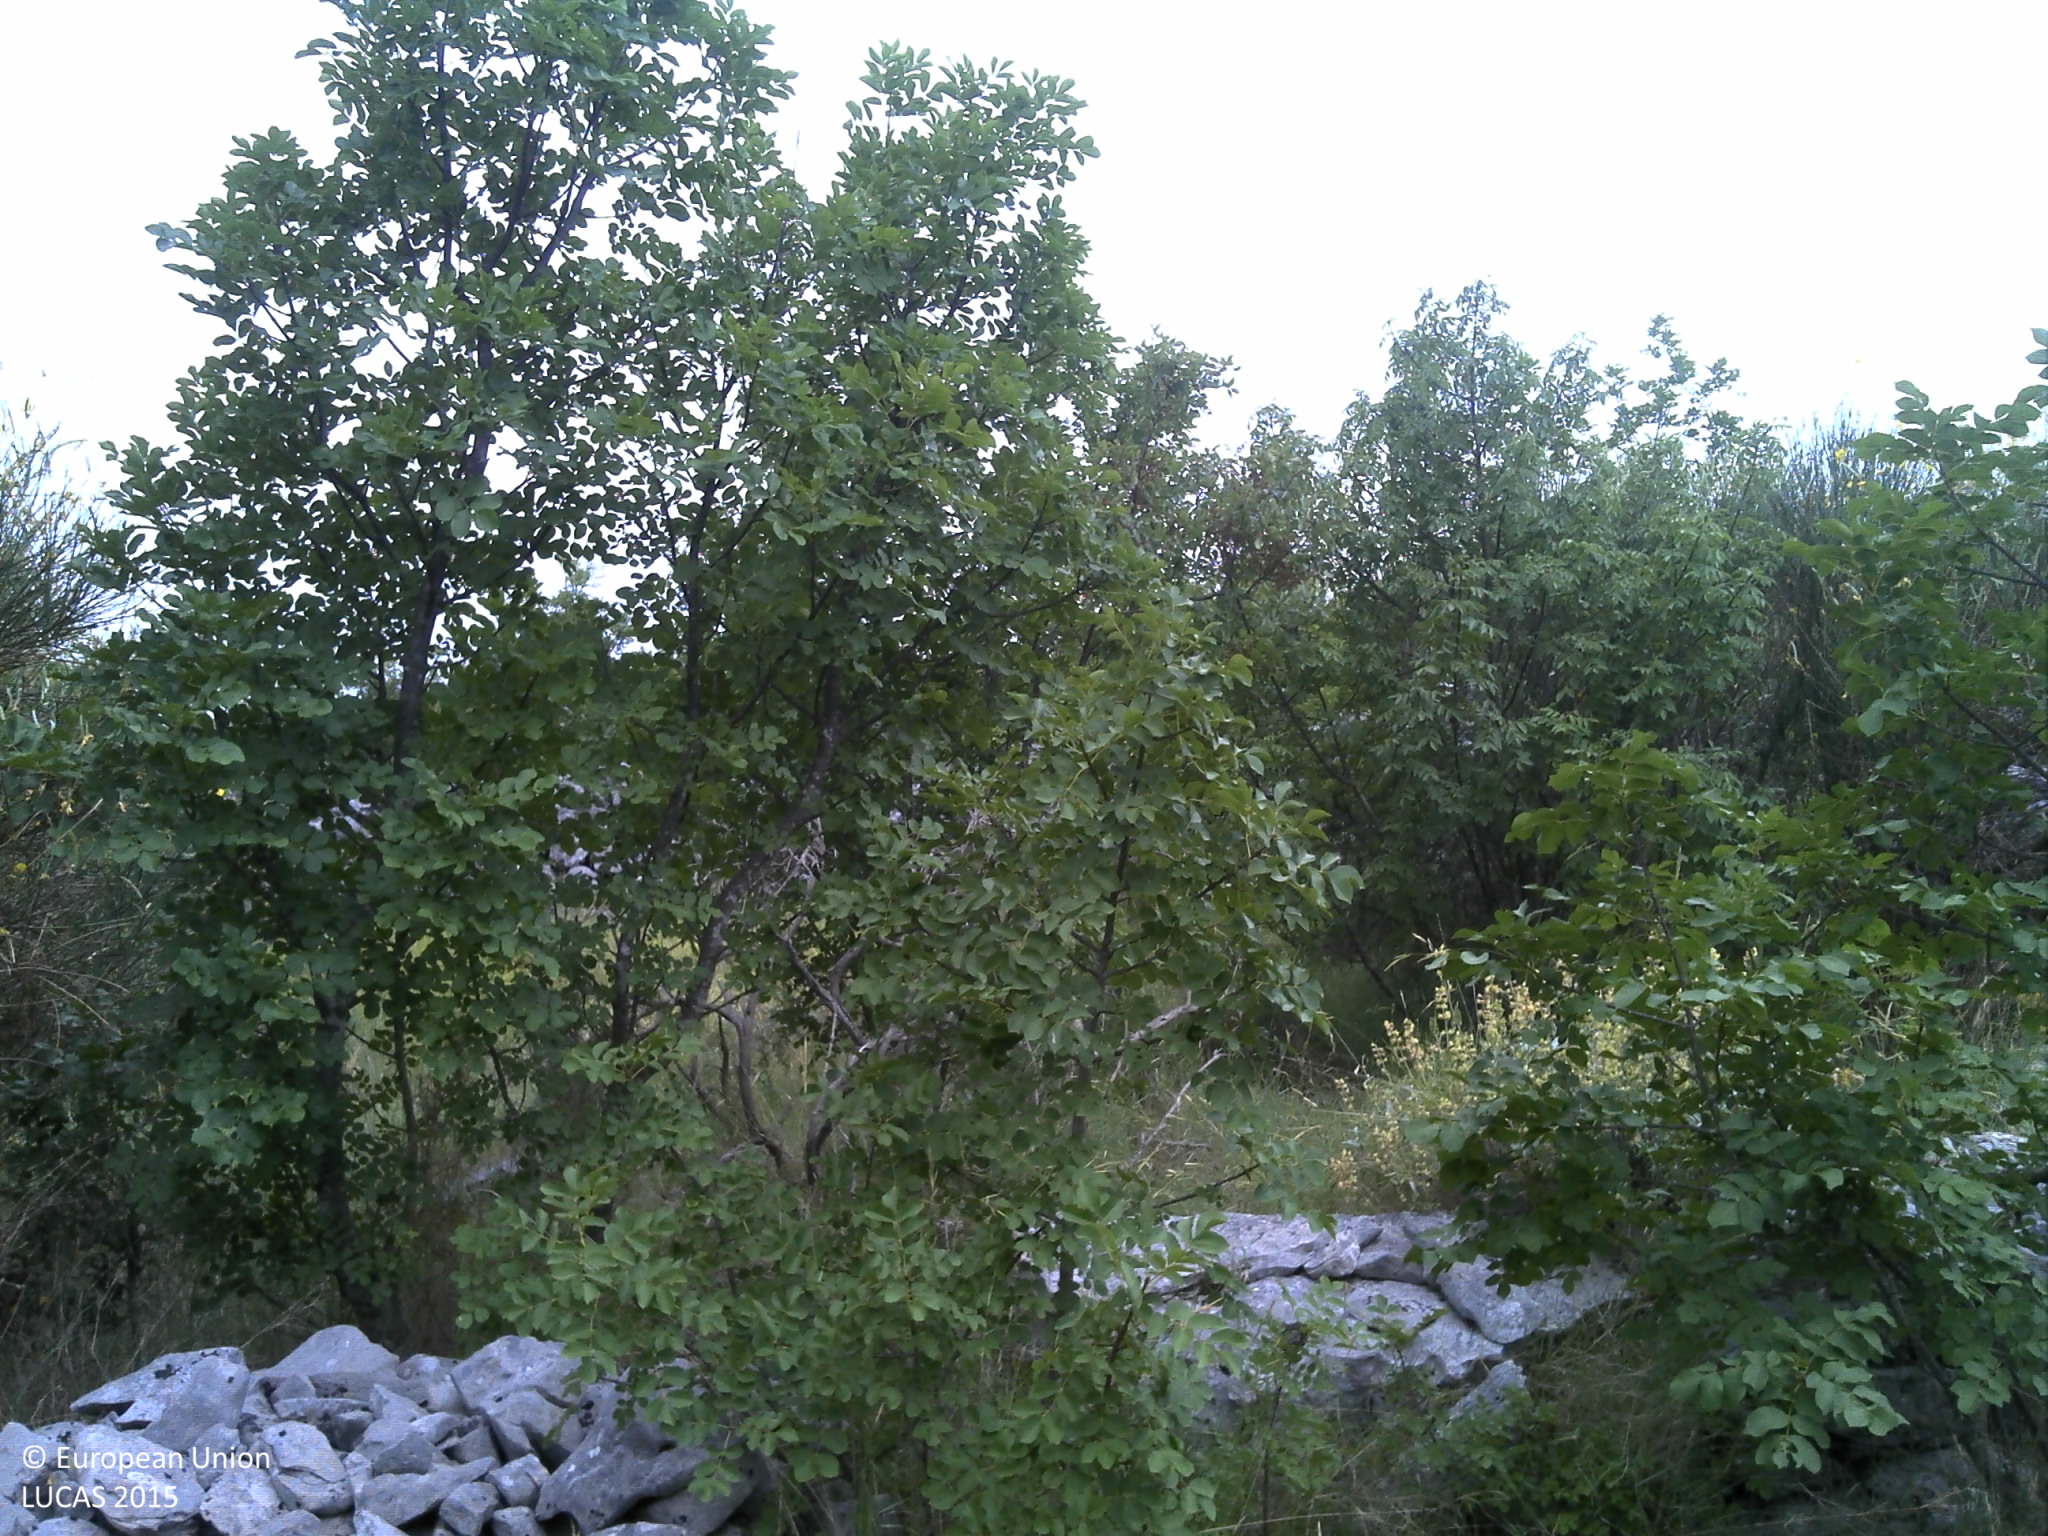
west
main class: Shrubland
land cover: Shrubland with sparse tree cover
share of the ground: 25 - 50 %
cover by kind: shrubs 40 %, herbaceous plants 25 %, consolidated bare surface 15 %, unconsolidated bare surface 15 %, broadleaved forest trees 5 %
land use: Semi-natural and natural areas not in use
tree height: < 5 m
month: June
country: HR
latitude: 43.5311
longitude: 16.2146
